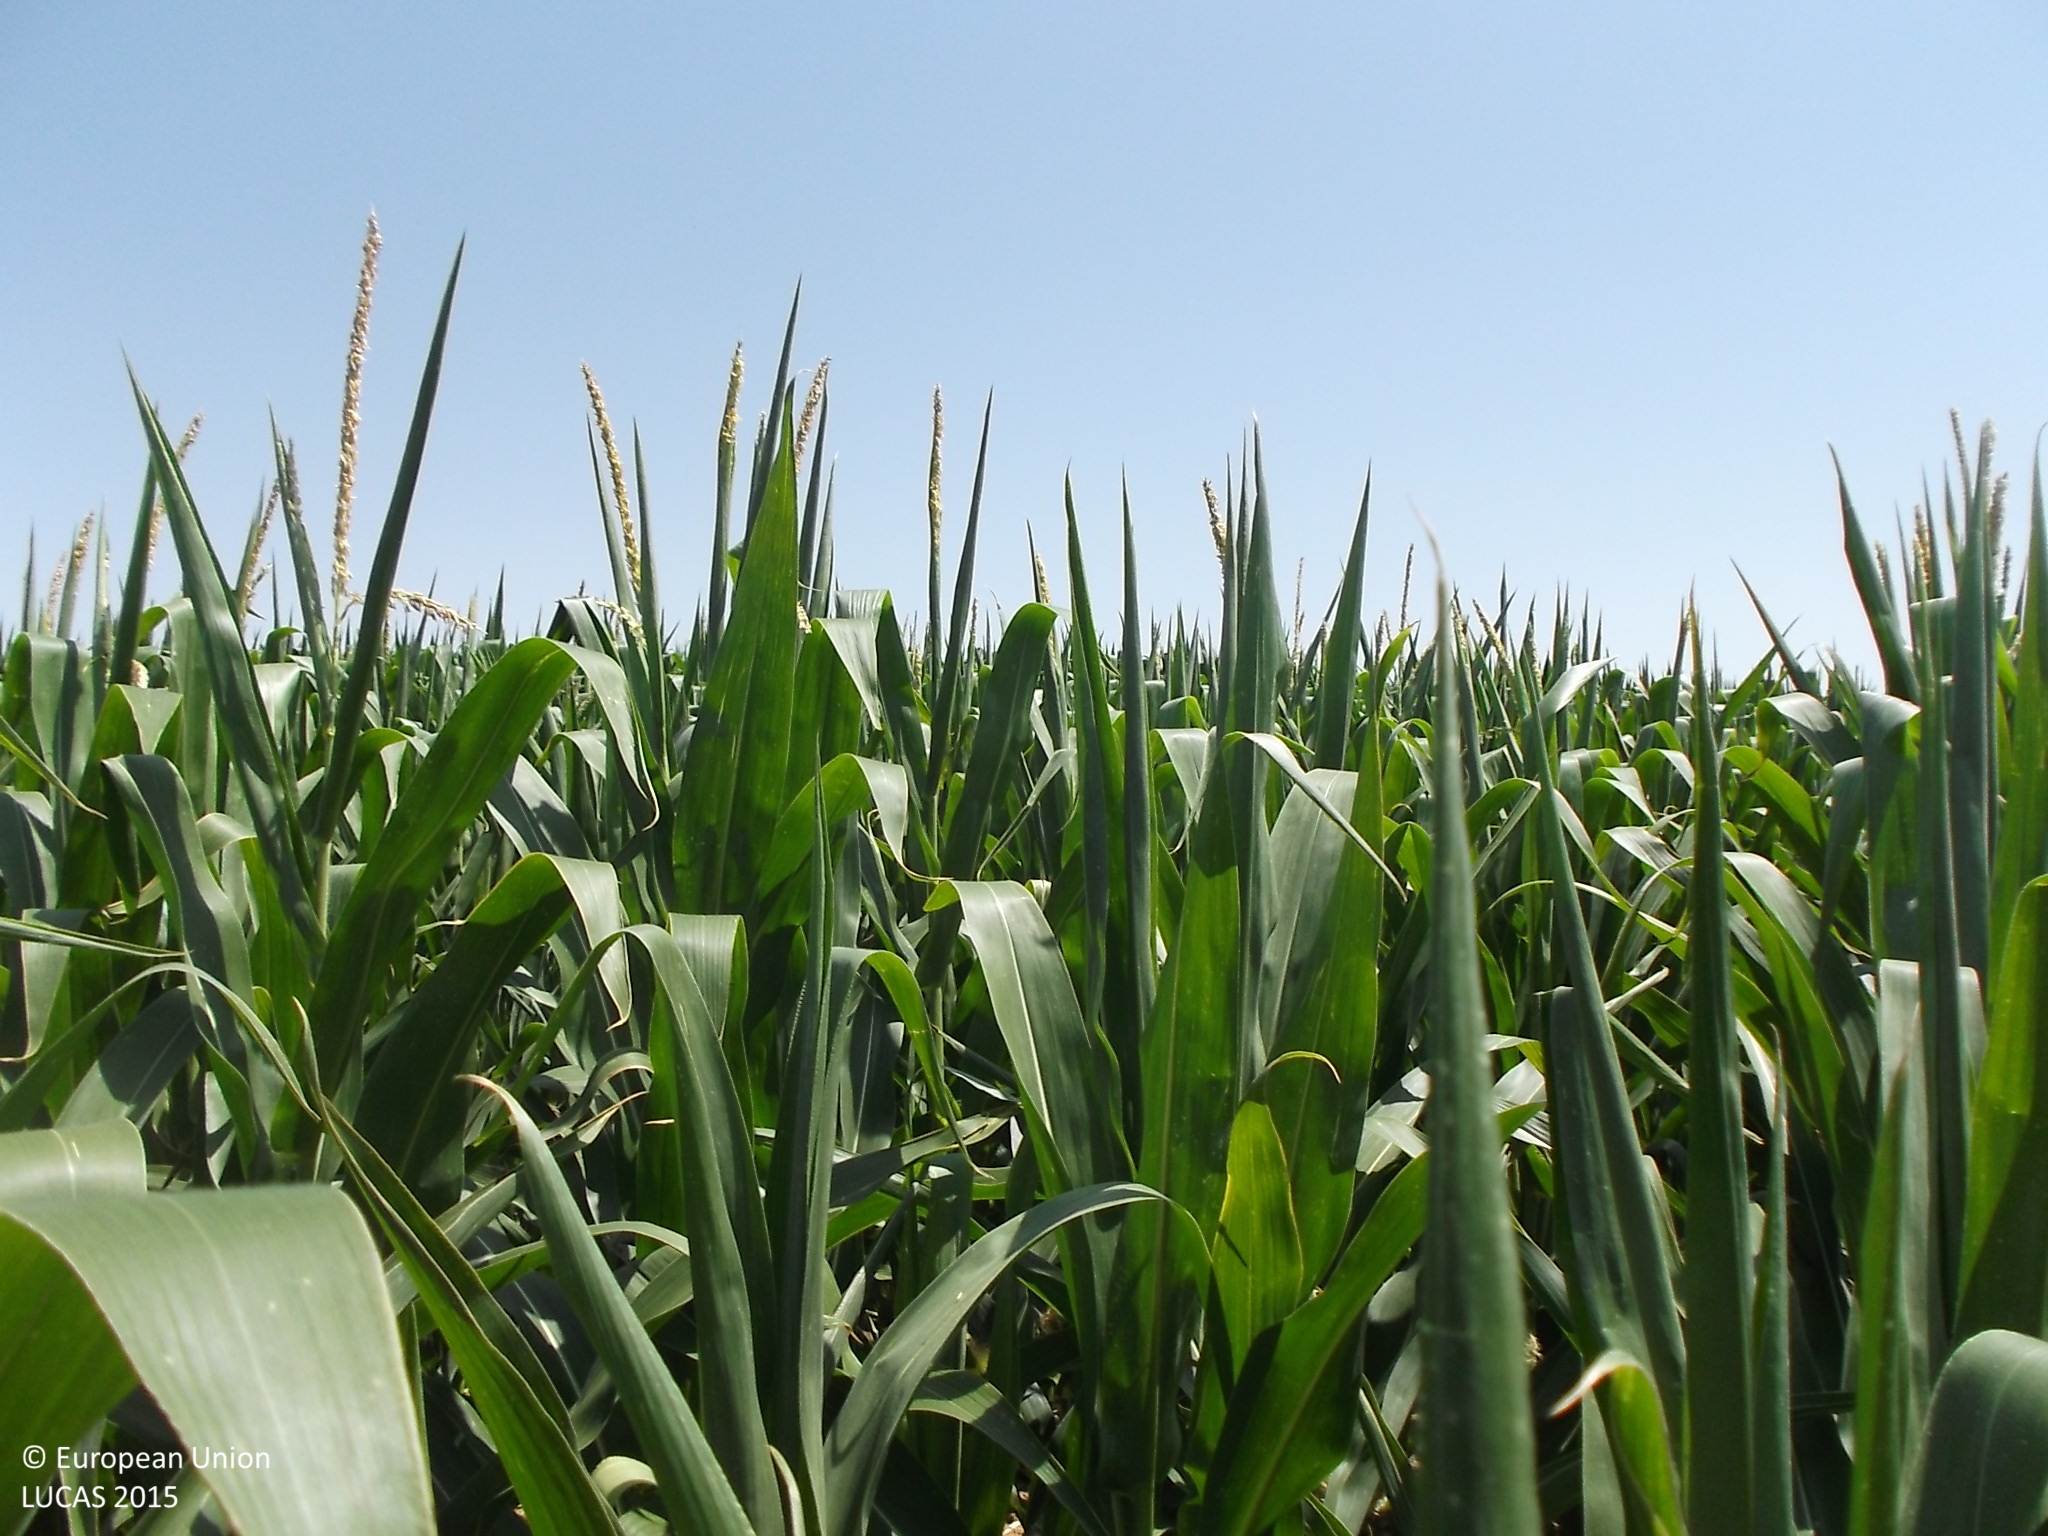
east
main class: Cropland
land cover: Maize
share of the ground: > 75 %
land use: Agriculture (excluding fallow land and kitchen gardens)
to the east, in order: Maize
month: July
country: ES
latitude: 41.5611
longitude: -5.3924
